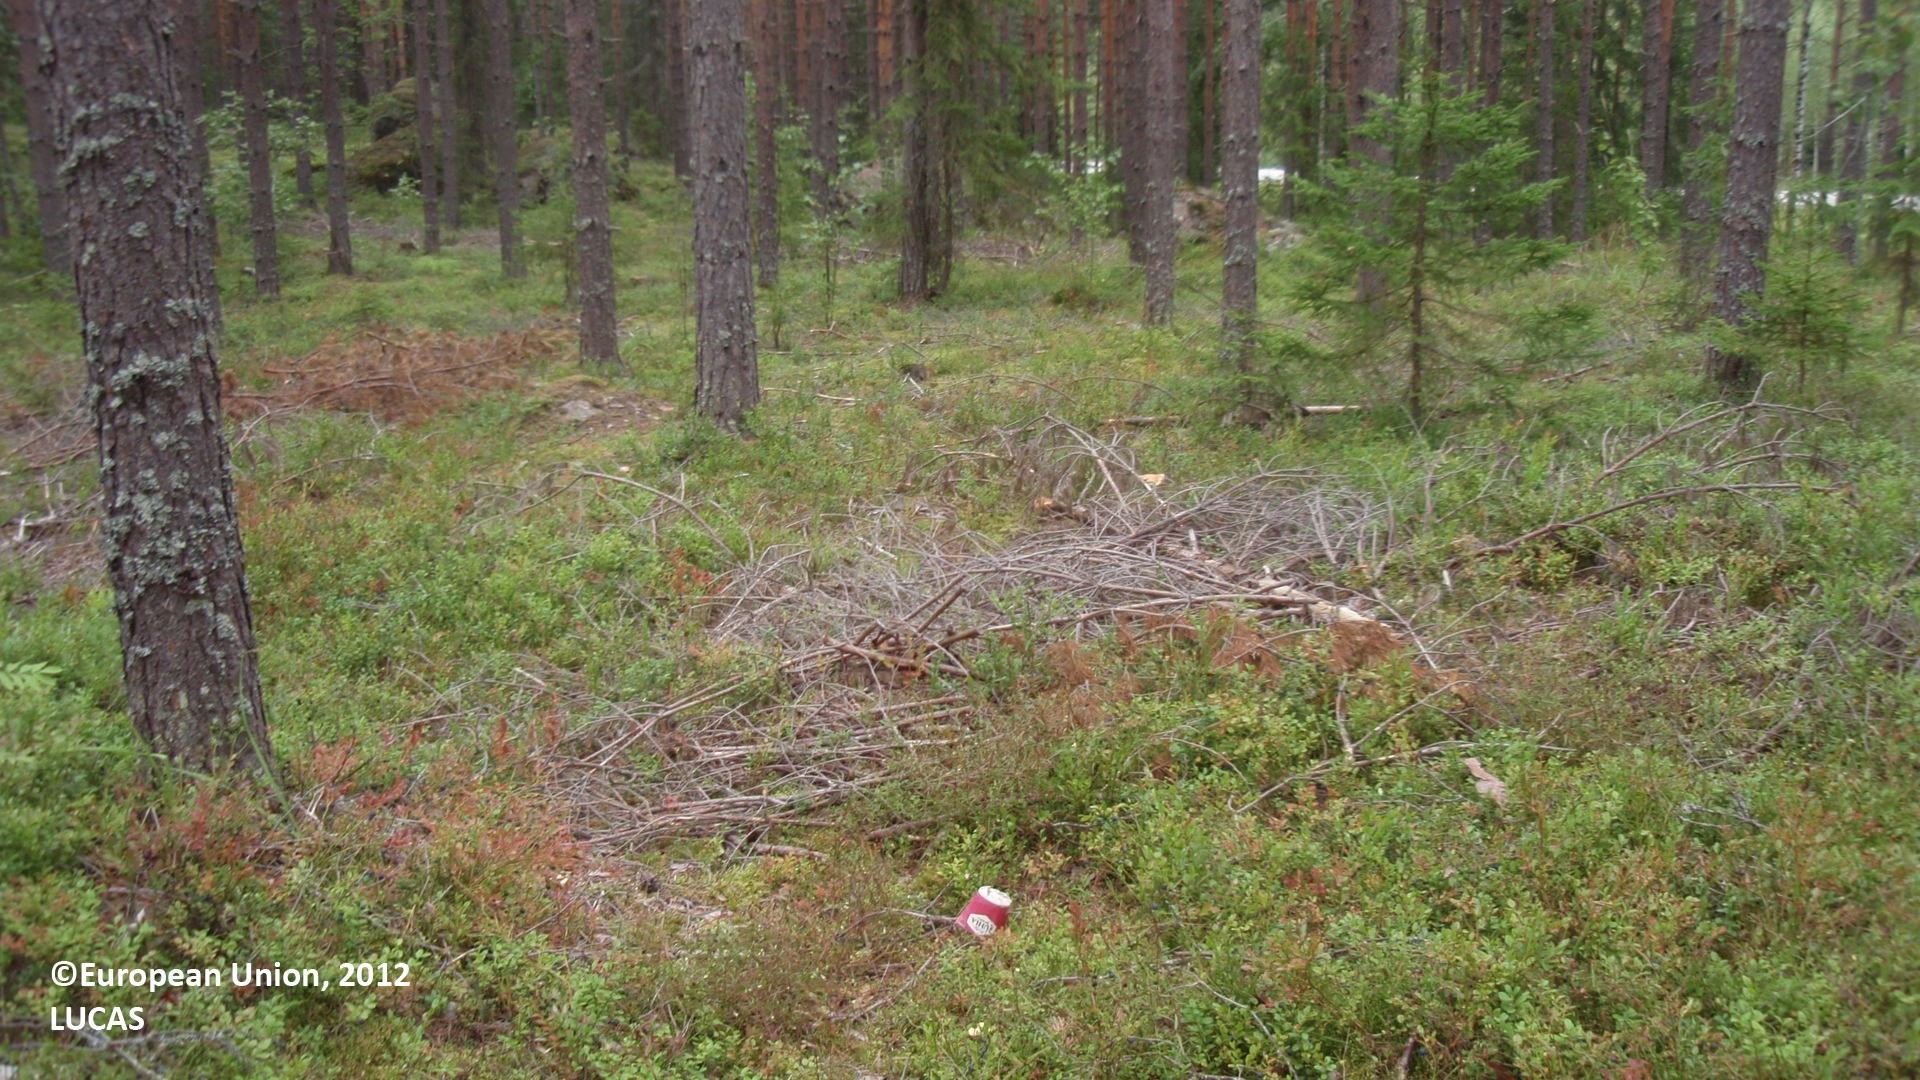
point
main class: Woodland
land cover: Pine dominated coniferous woodland
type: boreal forest
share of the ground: 50 - 75 %
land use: Forestry
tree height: > 5 m
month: August
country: FI
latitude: 60.7769
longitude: 27.3480
